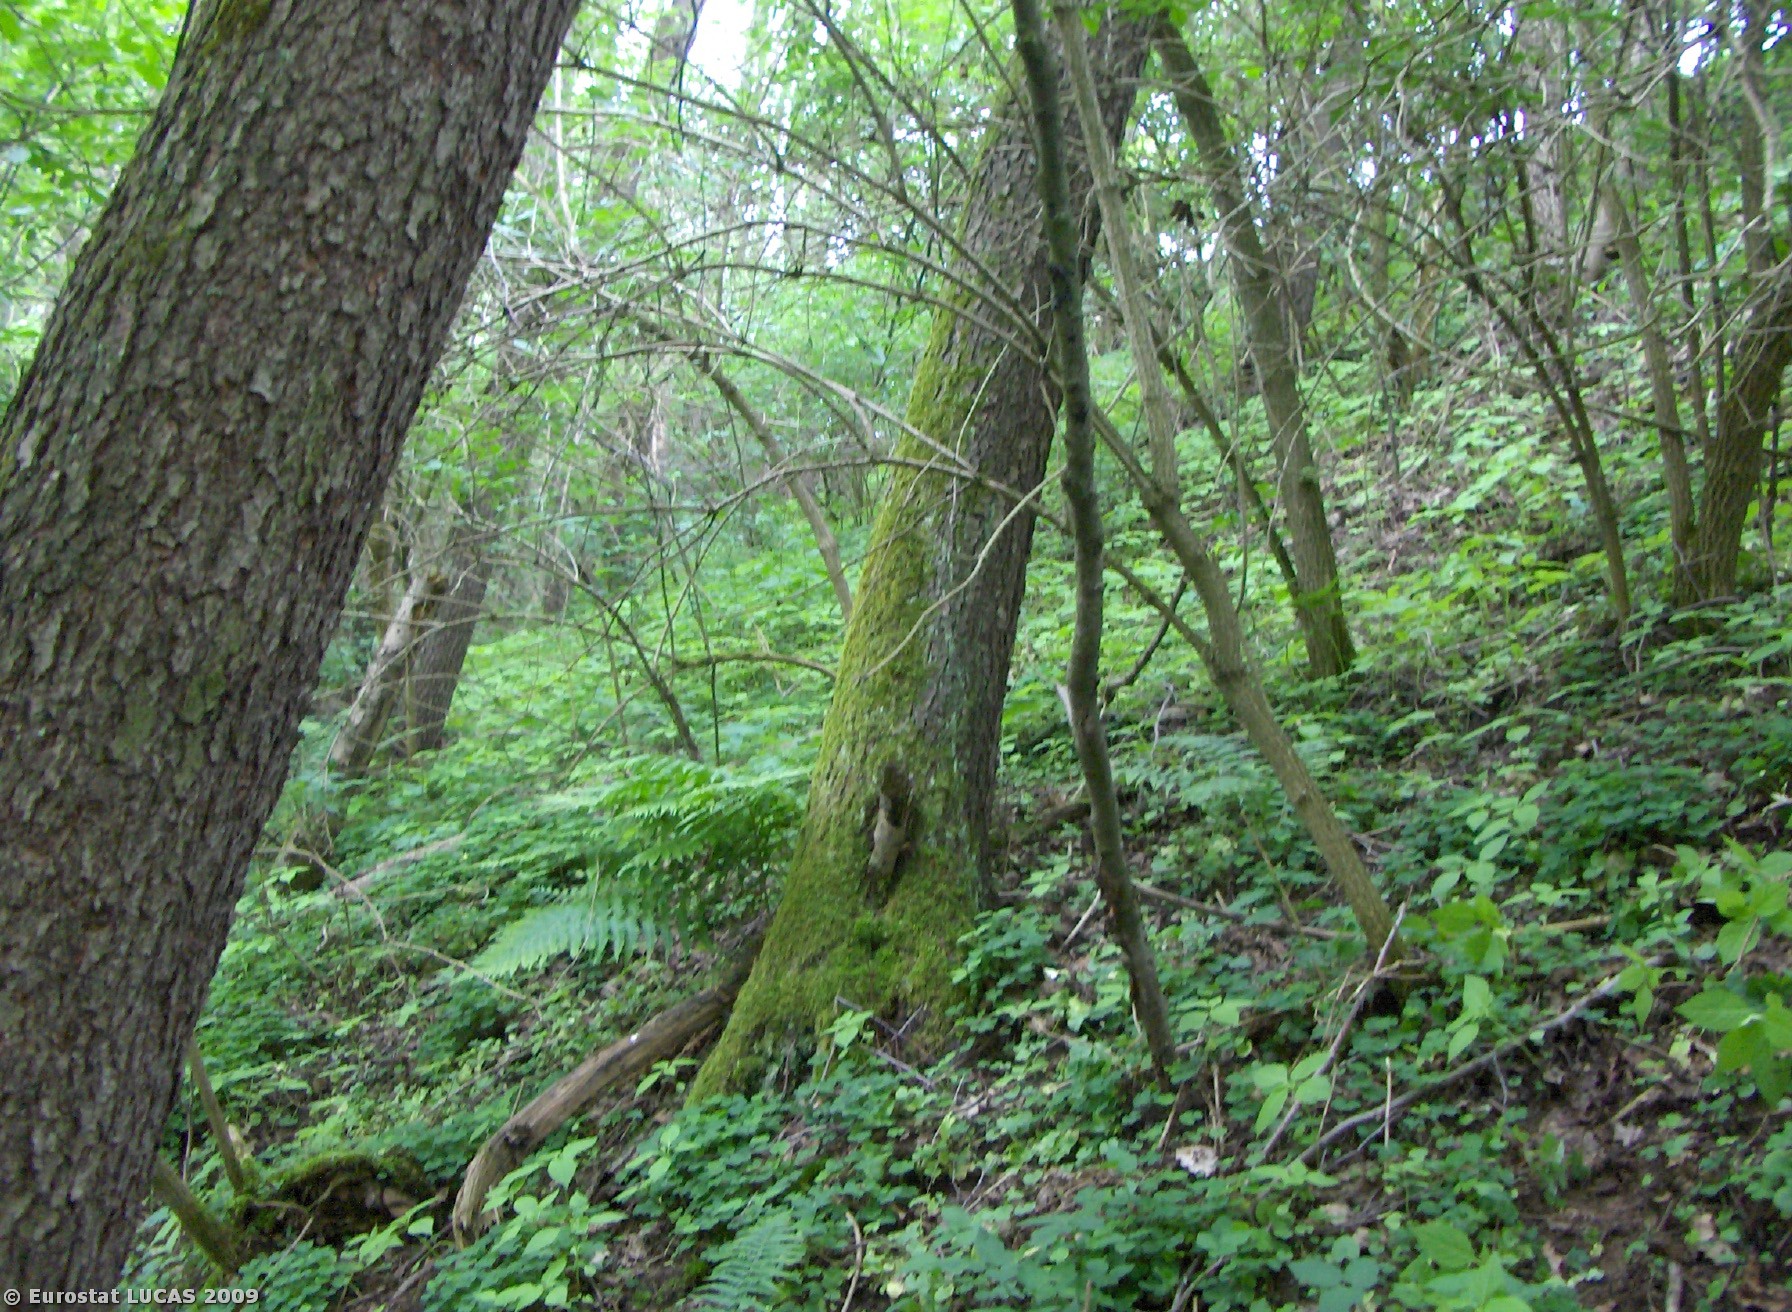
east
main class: Woodland
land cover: Broadleaved woodland
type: mesophytic deciduous forest
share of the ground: > 75 %
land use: Forestry
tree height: > 5 m
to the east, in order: Broadleaved woodland; Oats; Barley
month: May
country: CZ
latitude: 49.6146
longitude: 14.3610
